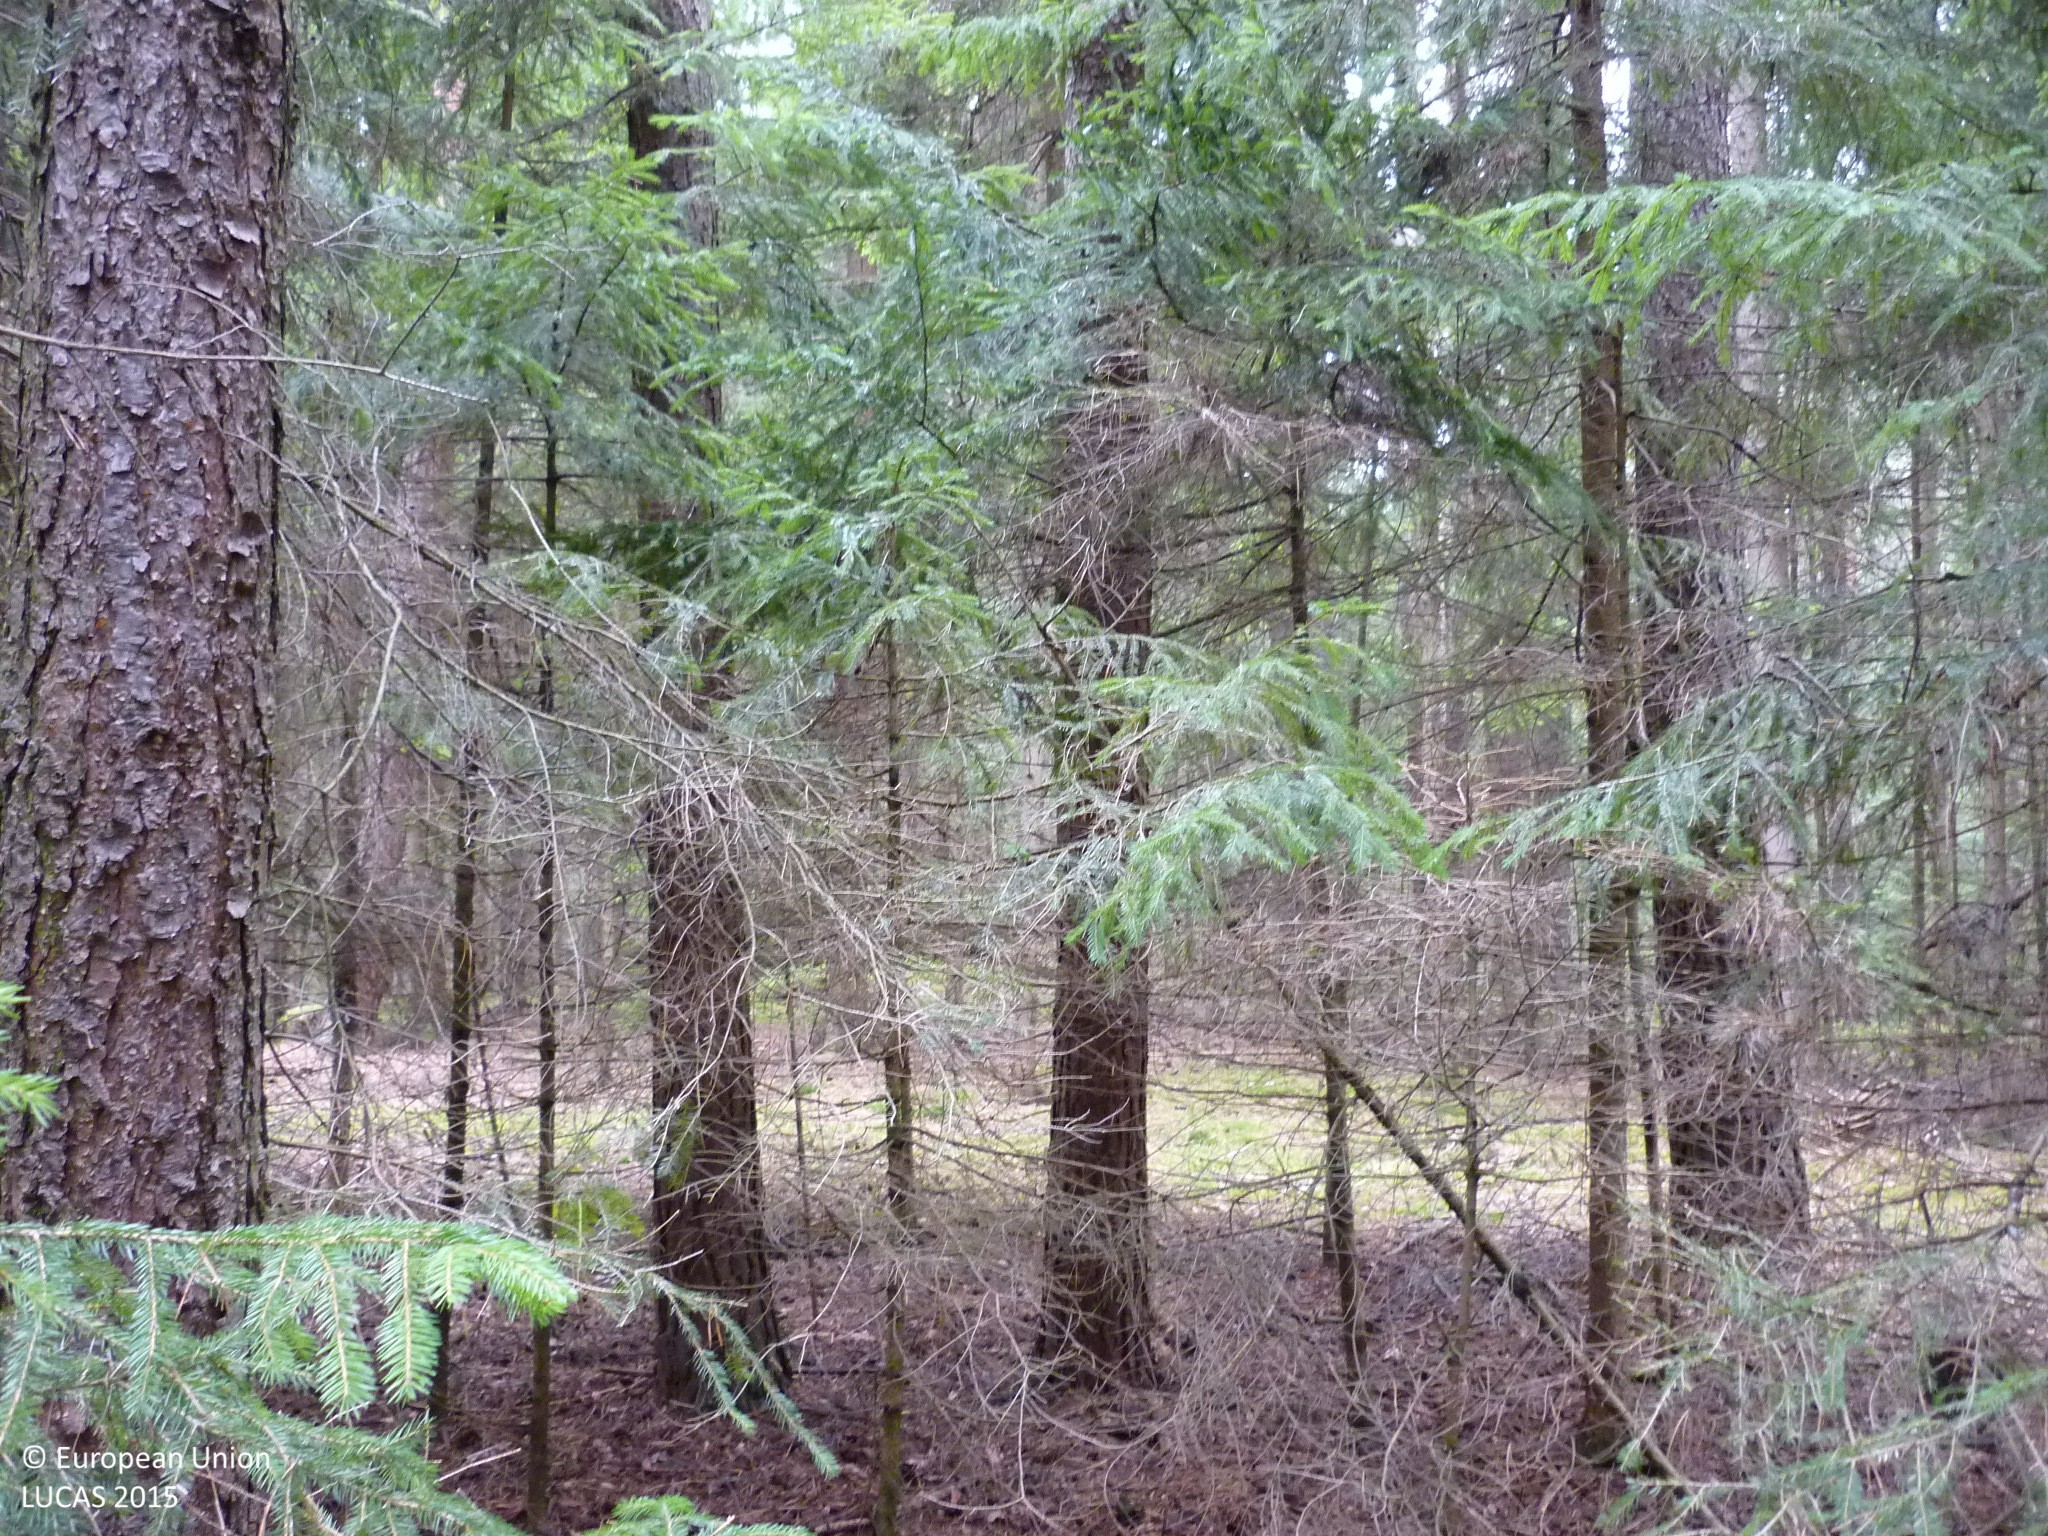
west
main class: Woodland
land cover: Spruce dominated coniferous woodland
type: hemiboreal forest and nemoral coniferous forest and mixed broadleaved-coniferous forest
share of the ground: > 75 %
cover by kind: coniferous forest trees 95 %, lichens and mosses 5 %
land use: Forestry
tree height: > 5 m
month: September
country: AT
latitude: 48.8837
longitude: 15.0342
